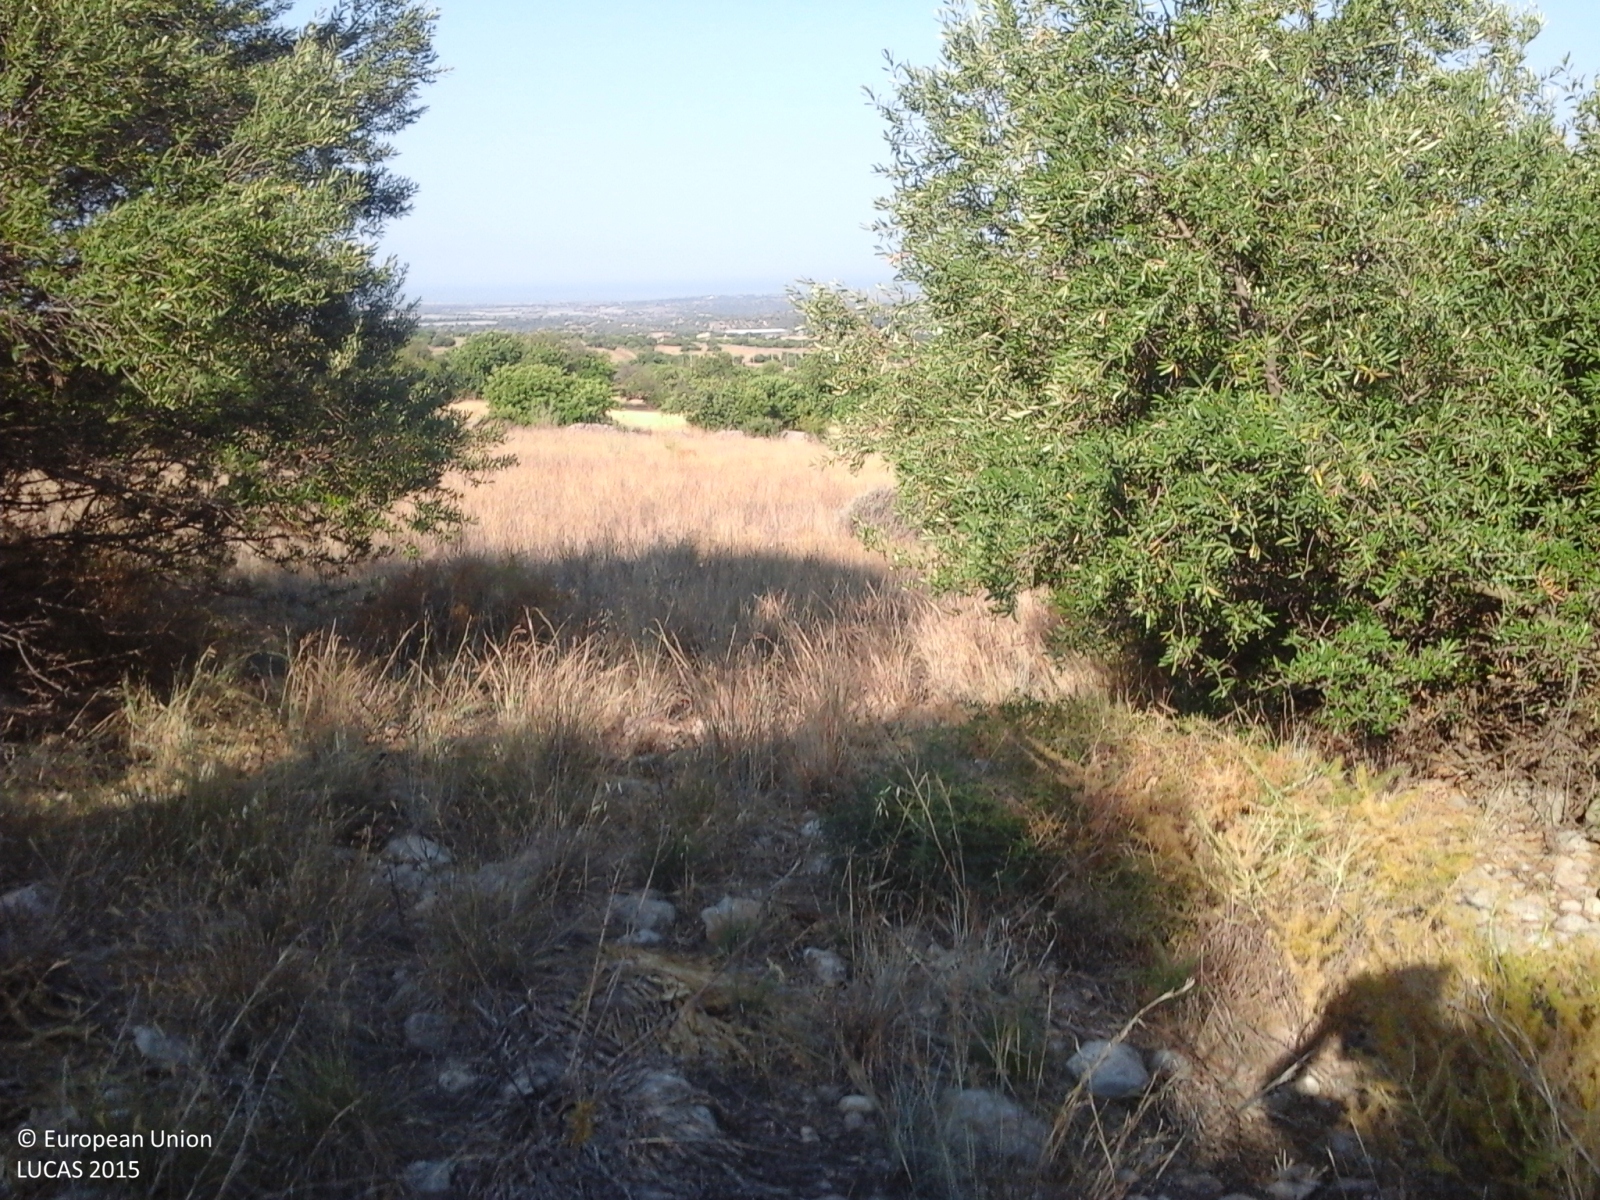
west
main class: Cropland
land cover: Olive groves
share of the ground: 10 - 25 %
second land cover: Spontaneously vegetated surfaces
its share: > 75 %
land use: Agriculture (excluding fallow land and kitchen gardens)
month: July
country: IT
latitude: 36.9109
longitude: 14.5541
